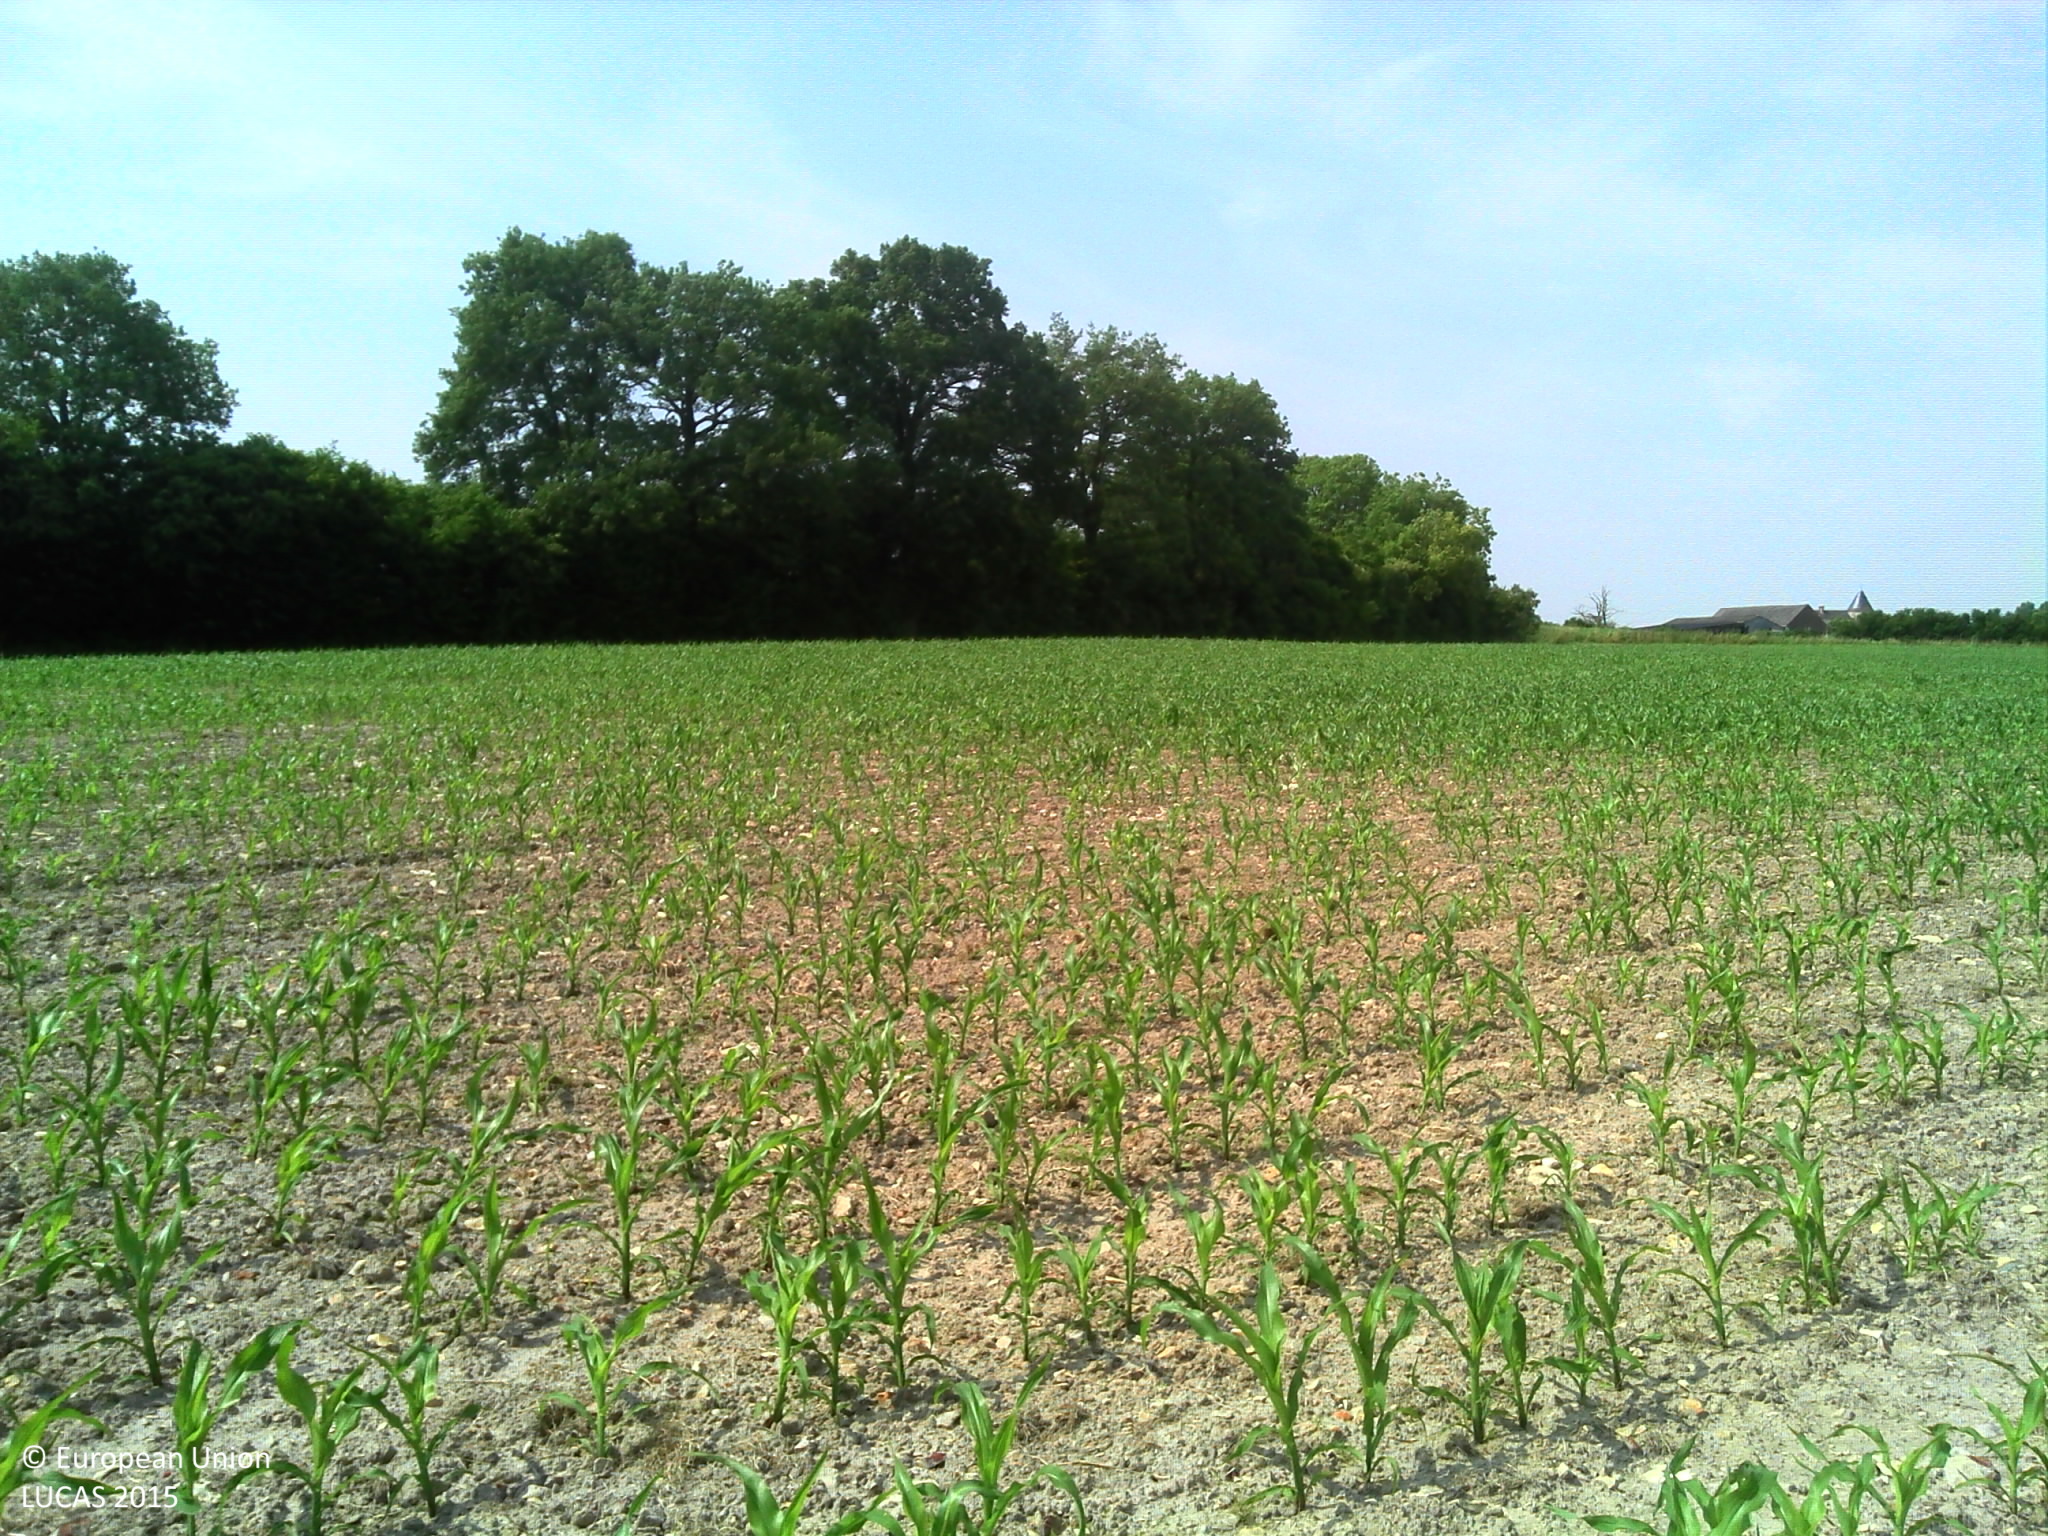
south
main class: Cropland
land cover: Maize
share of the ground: 10 - 25 %
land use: Agriculture (excluding fallow land and kitchen gardens)
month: June
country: FR
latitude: 47.5950
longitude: 0.0933
